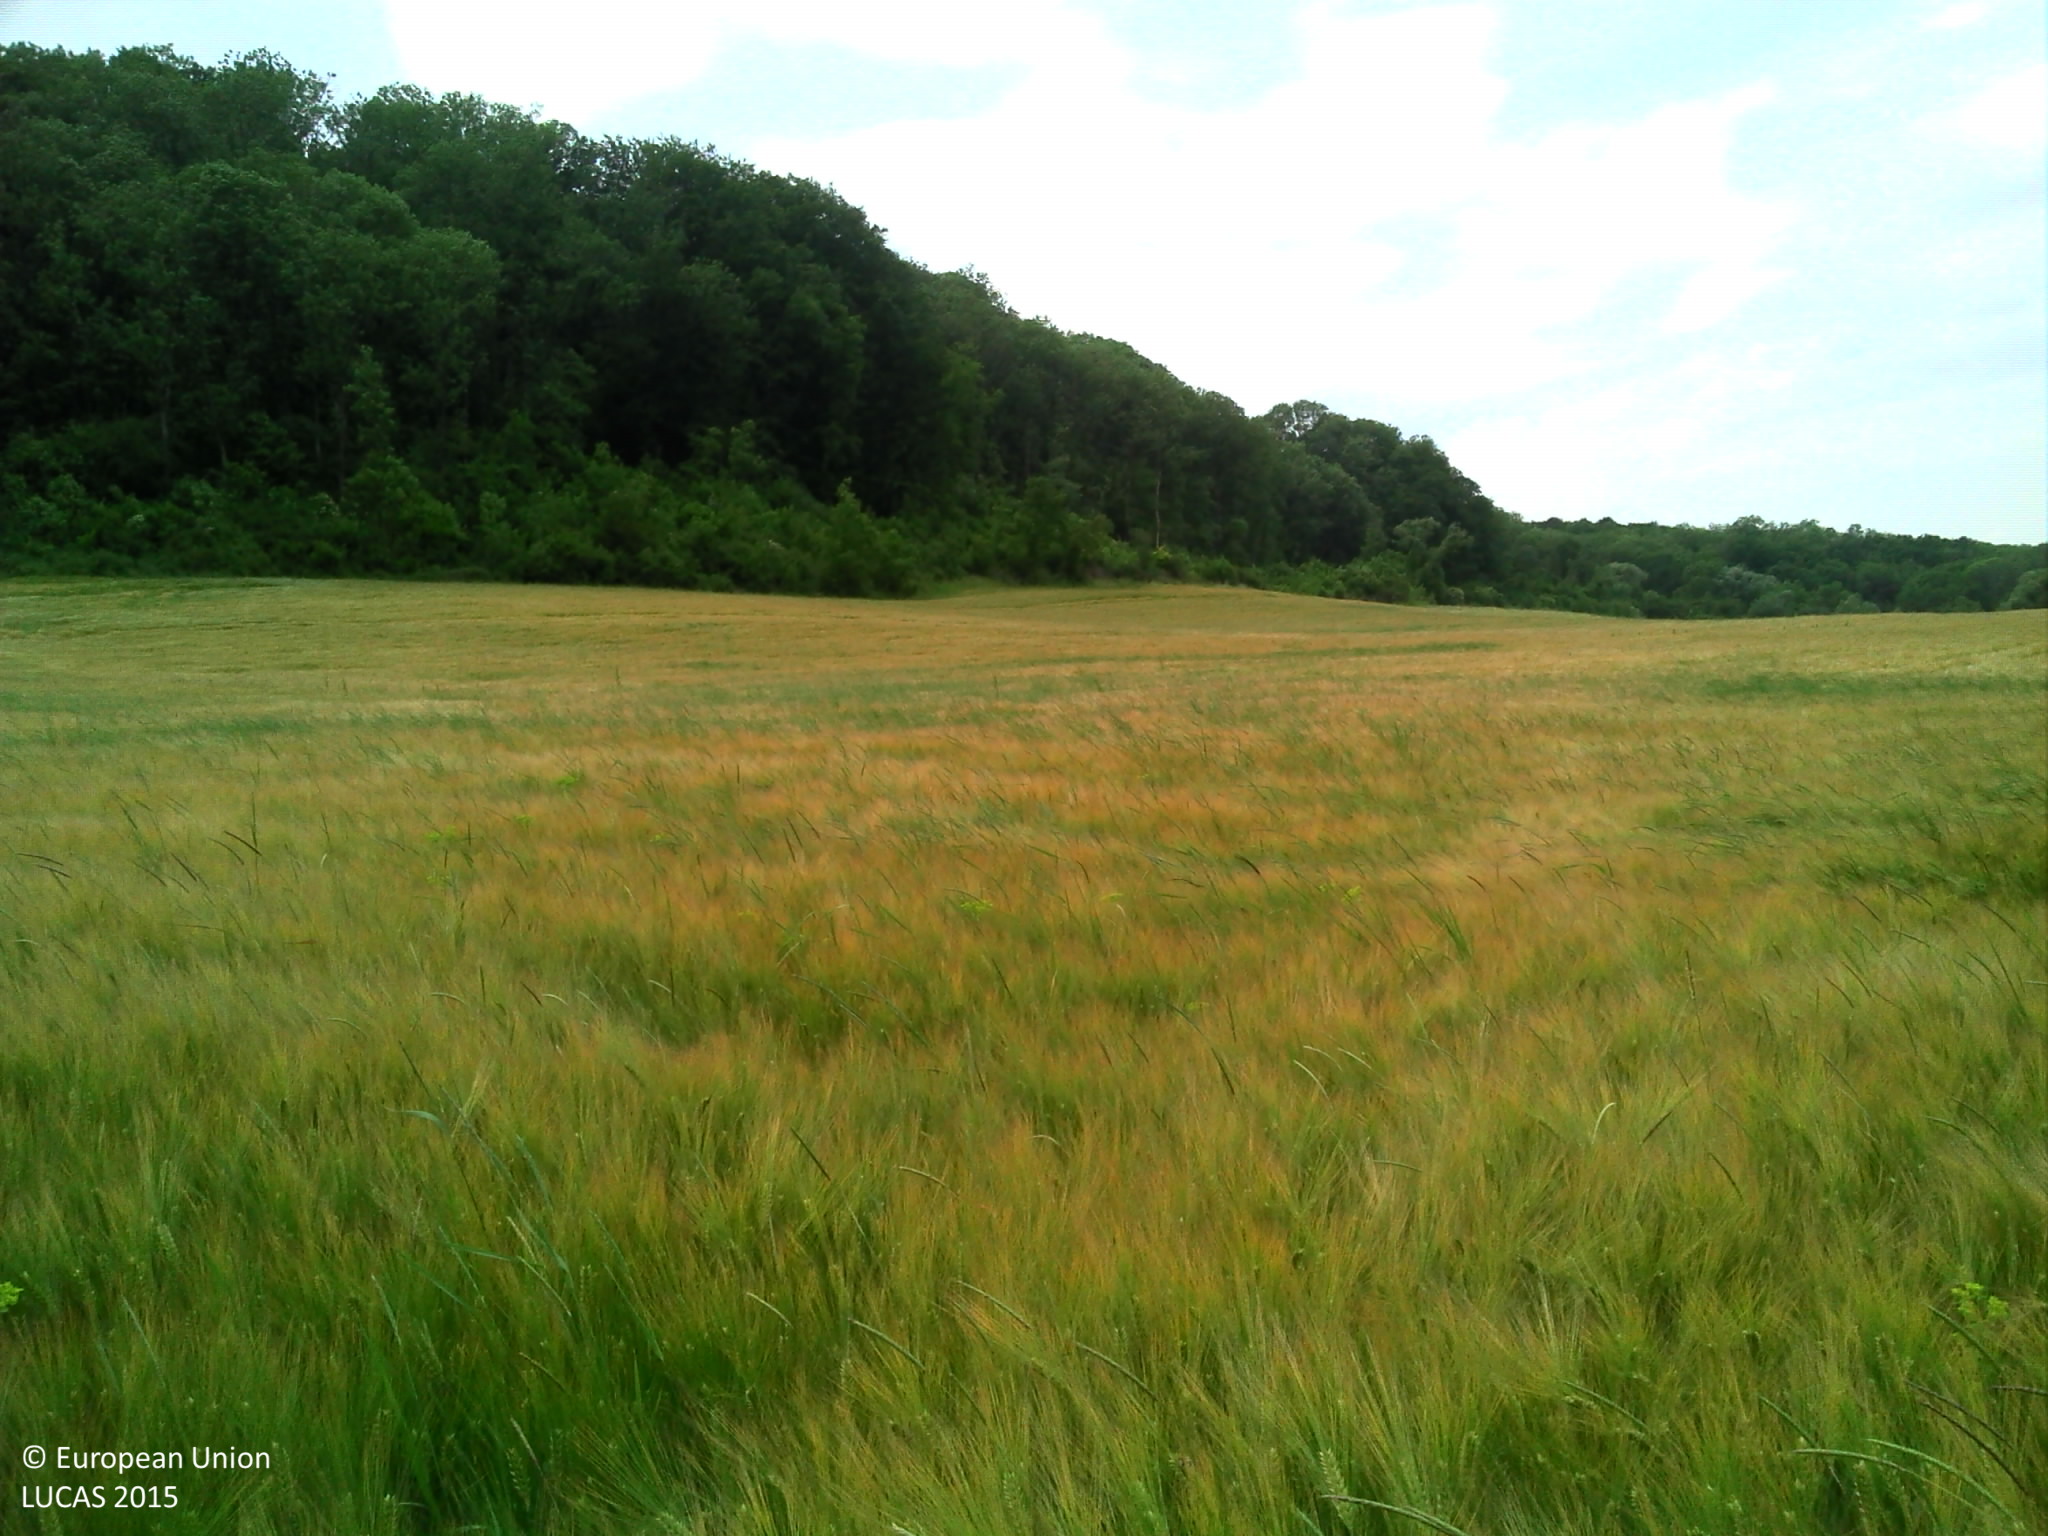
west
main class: Cropland
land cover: Barley
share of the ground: > 75 %
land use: Agriculture (excluding fallow land and kitchen gardens)
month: June
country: FR
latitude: 48.5200
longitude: 6.2499
